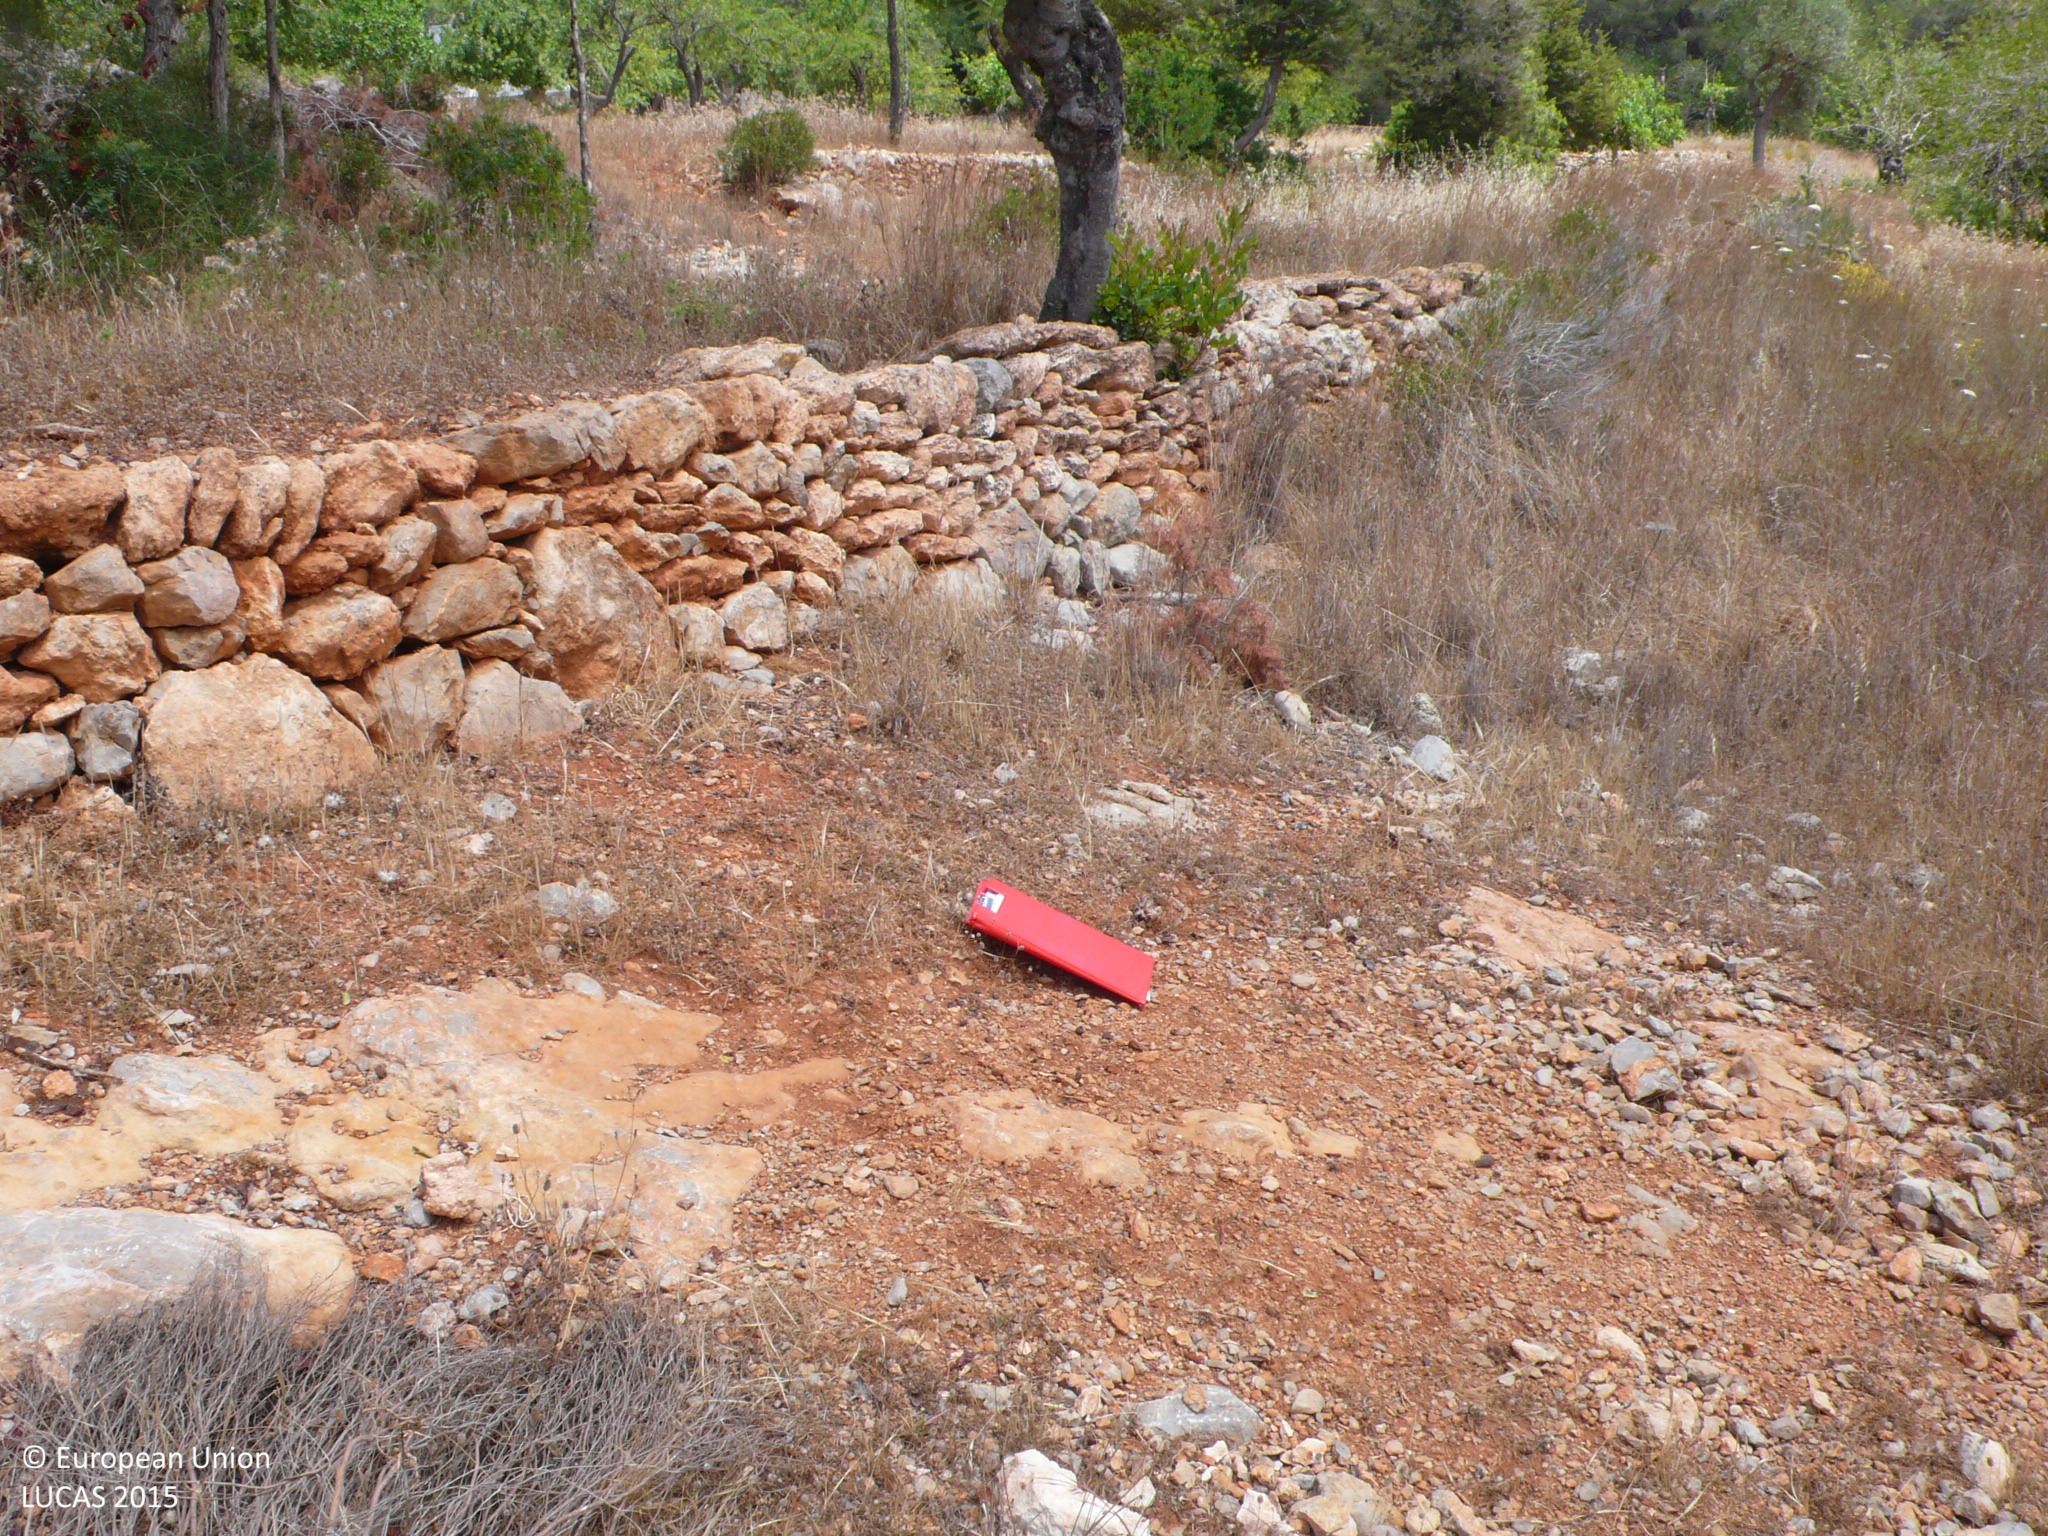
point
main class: Cropland
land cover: Permanent industrial crops
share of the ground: 10 - 25 %
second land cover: Spontaneously vegetated surfaces
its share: 50 - 75 %
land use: Abandoned areas
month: May
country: ES
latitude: 39.0463
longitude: 1.5423
